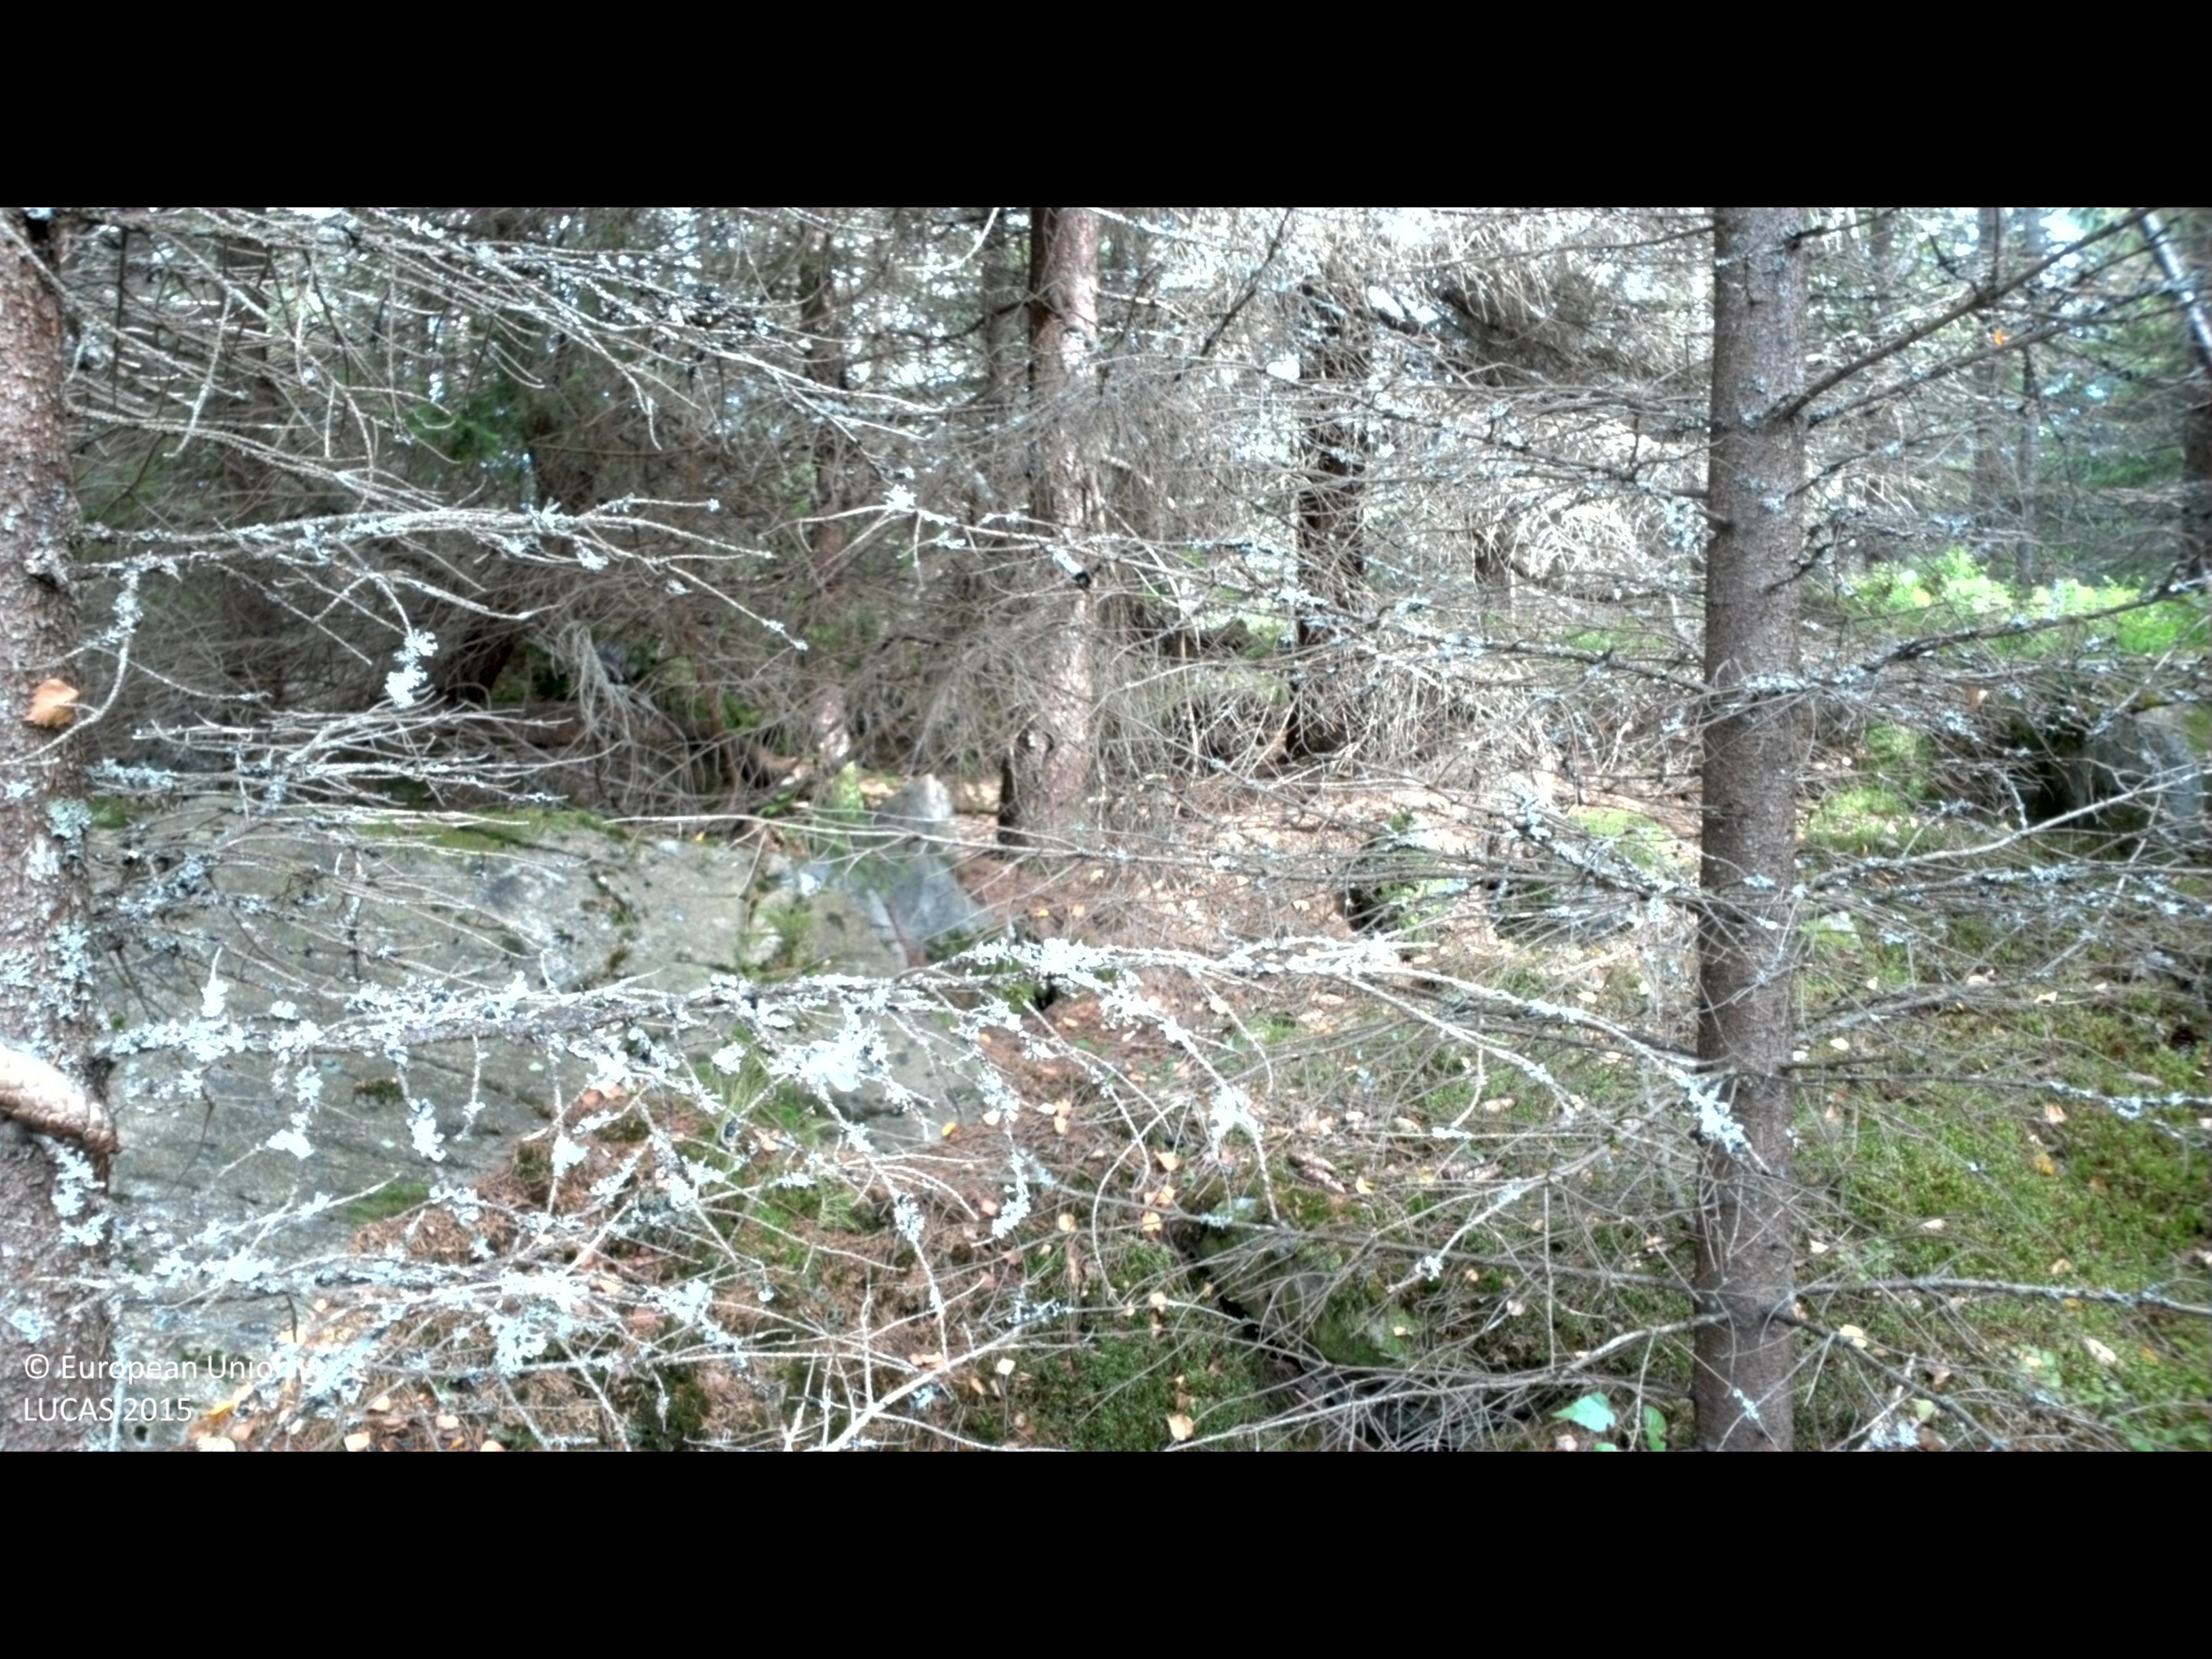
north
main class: Woodland
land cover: Spruce dominated coniferous woodland
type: boreal forest
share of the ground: > 75 %
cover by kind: coniferous forest trees 85 %, broadleaved forest trees 5 %, shrubs 5 %, lichens and mosses 5 %
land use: Forestry
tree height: > 5 m
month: August
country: SE
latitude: 56.3280
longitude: 14.4127
